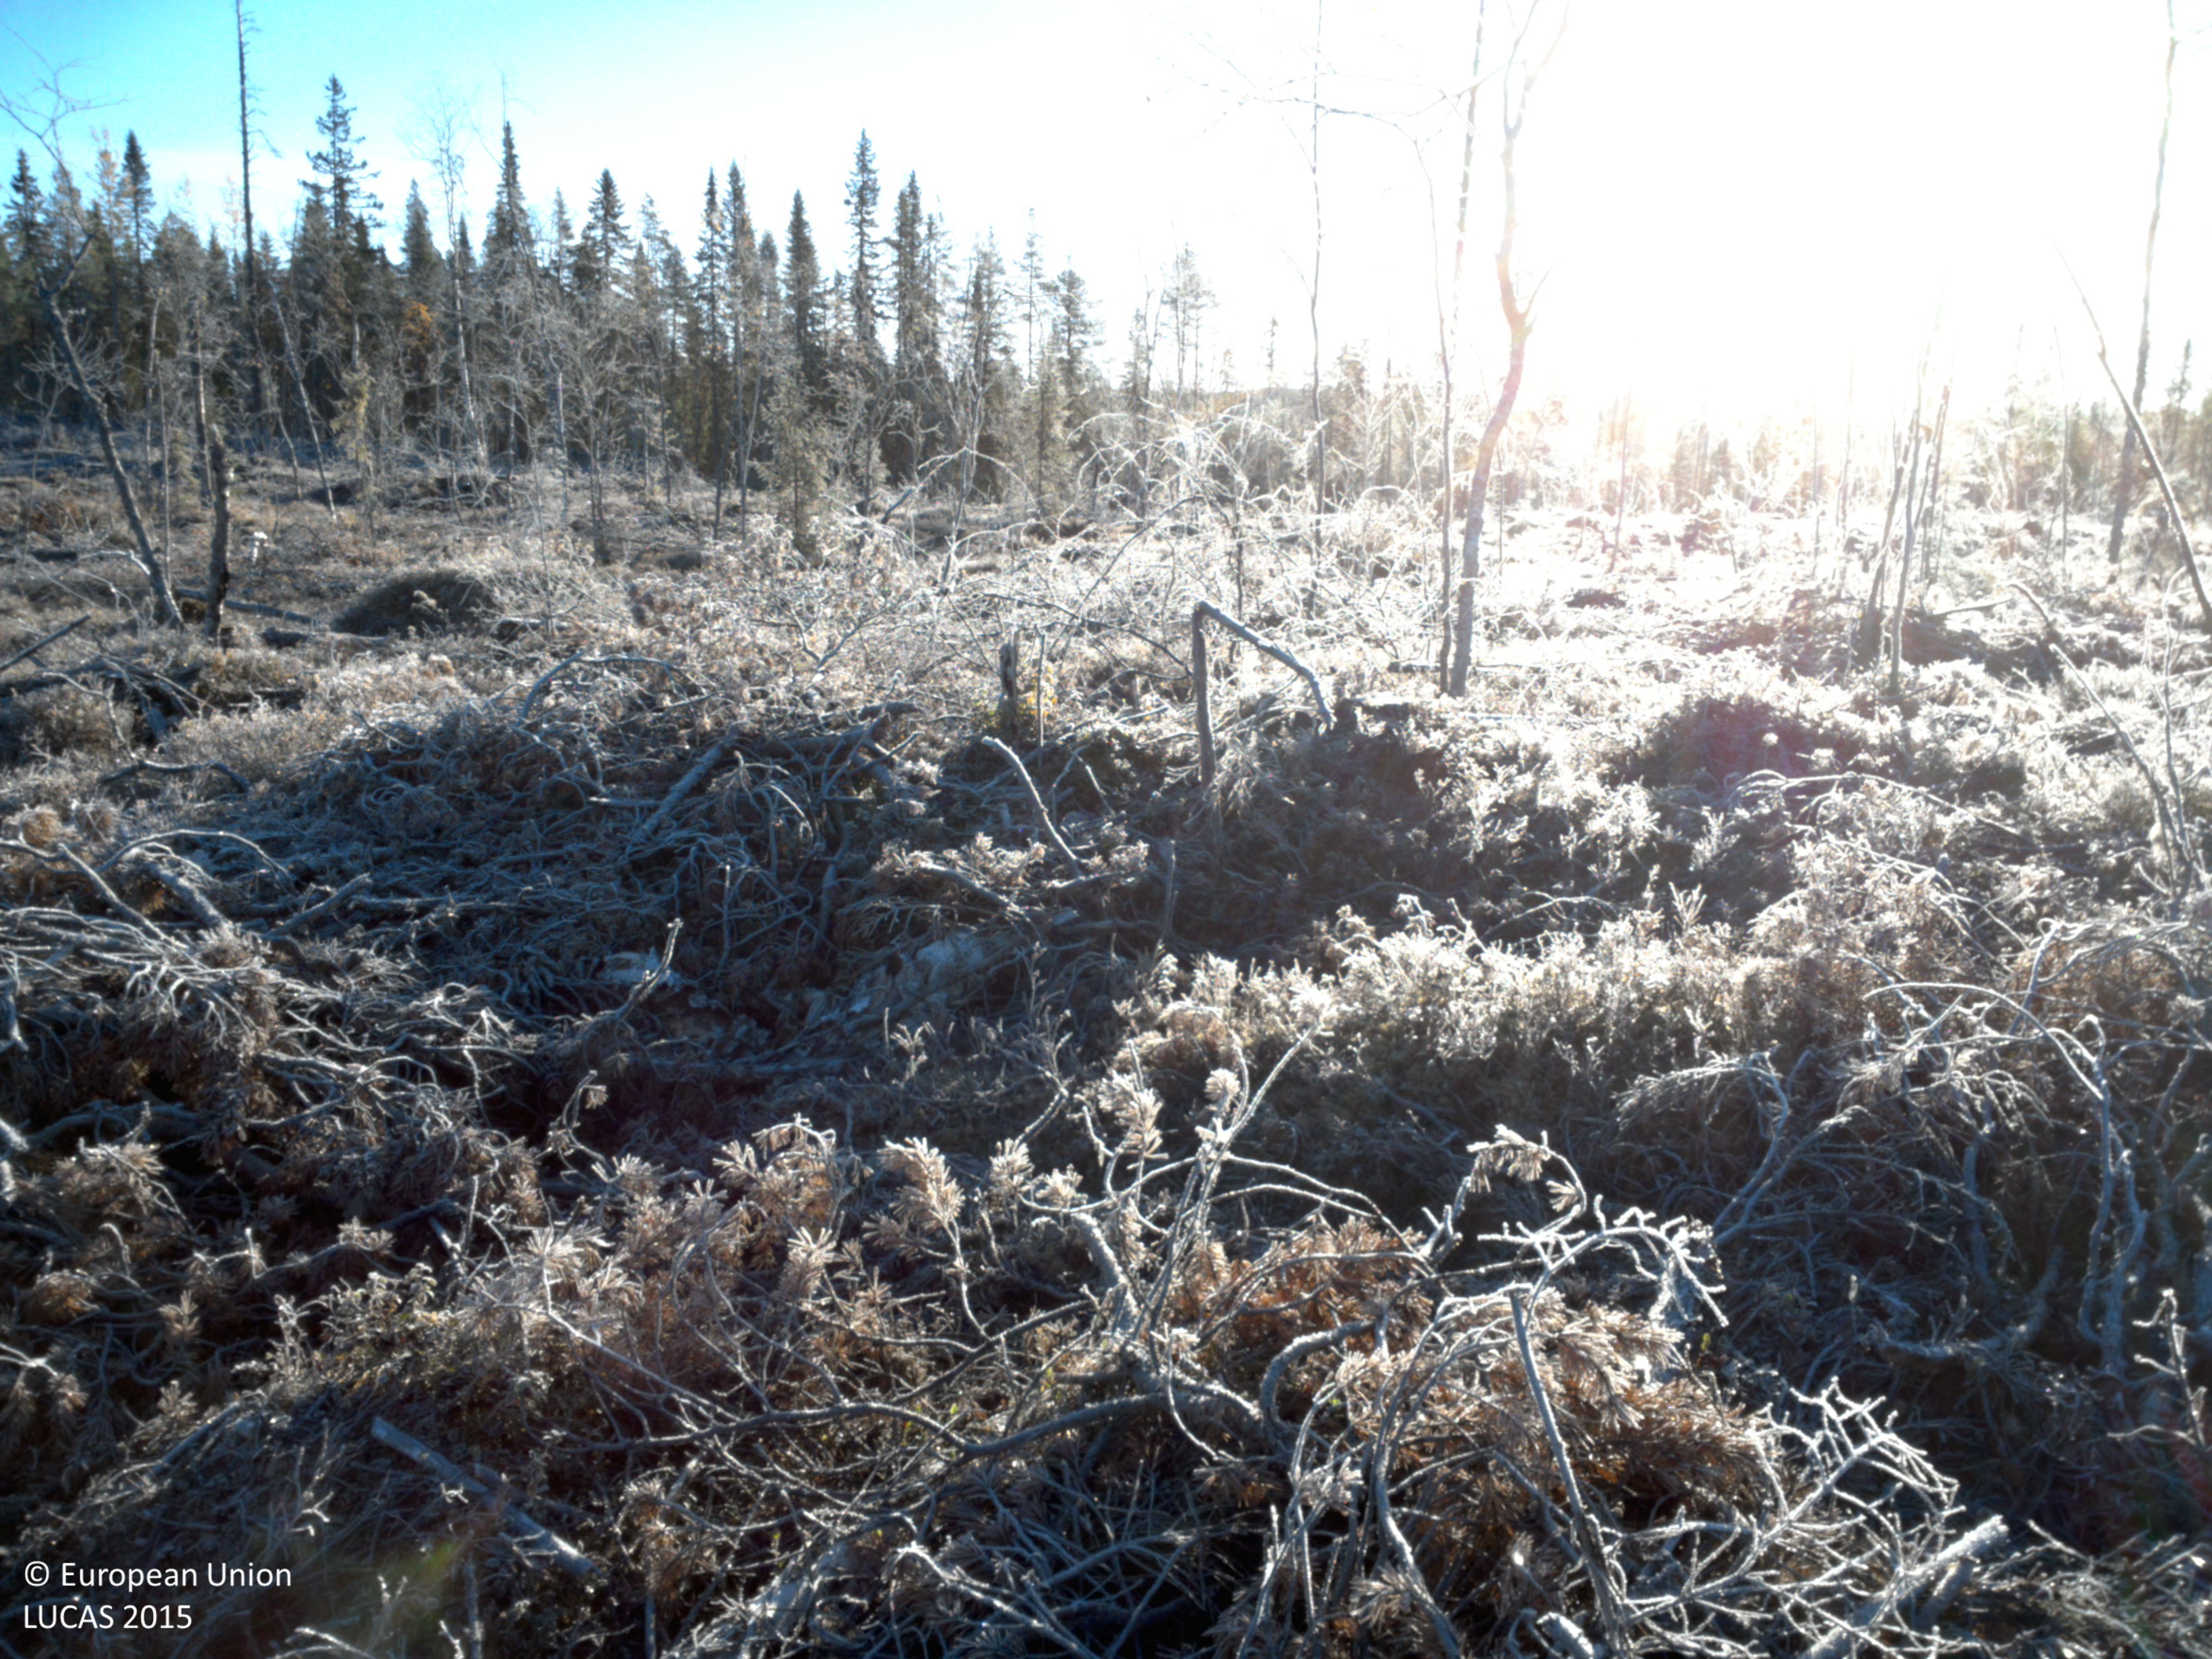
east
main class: Shrubland
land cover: Shrubland with sparse tree cover
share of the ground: 10 - 25 %
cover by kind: shrubs 10 %, coniferous forest trees 5 %
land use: Forestry
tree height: < 5 m
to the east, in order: Shrubland with sparse tree cover; Spruce dominated mixed woodland; Inland fresh water bodies; Spruce dominated mixed woodland; Pine dominated mixed woodland
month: October
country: SE
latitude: 64.7331
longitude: 17.7976
